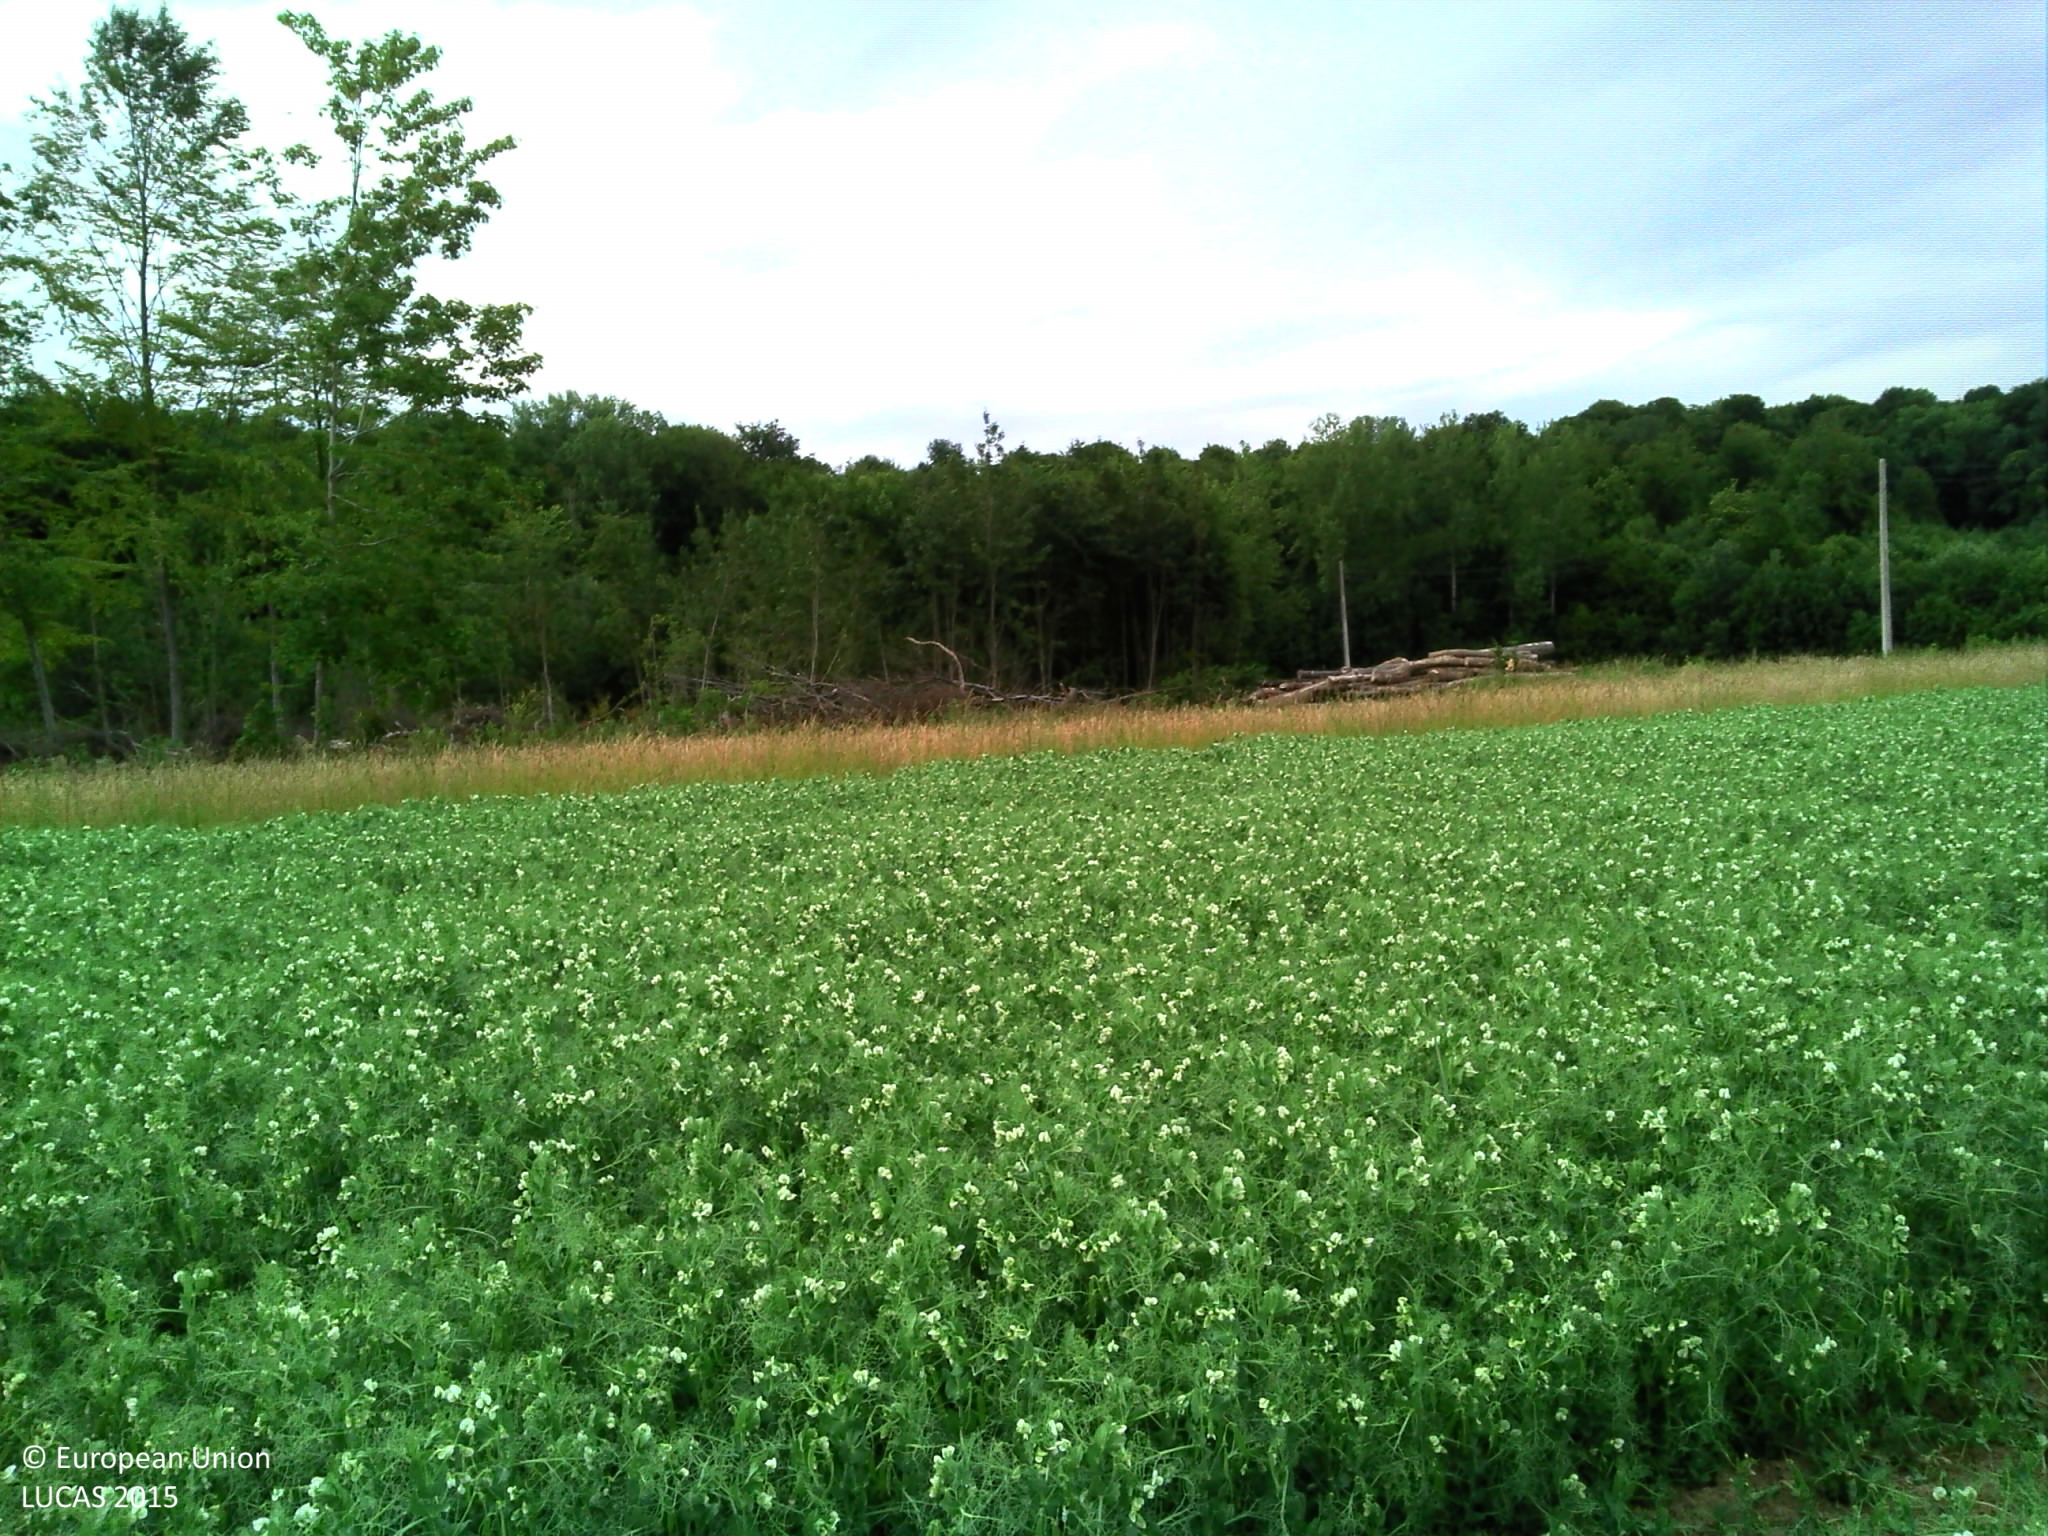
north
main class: Cropland
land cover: Dry pulses
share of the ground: > 75 %
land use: Agriculture (excluding fallow land and kitchen gardens)
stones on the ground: < 10 %
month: June
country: BE
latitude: 50.6382
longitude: 3.6441
